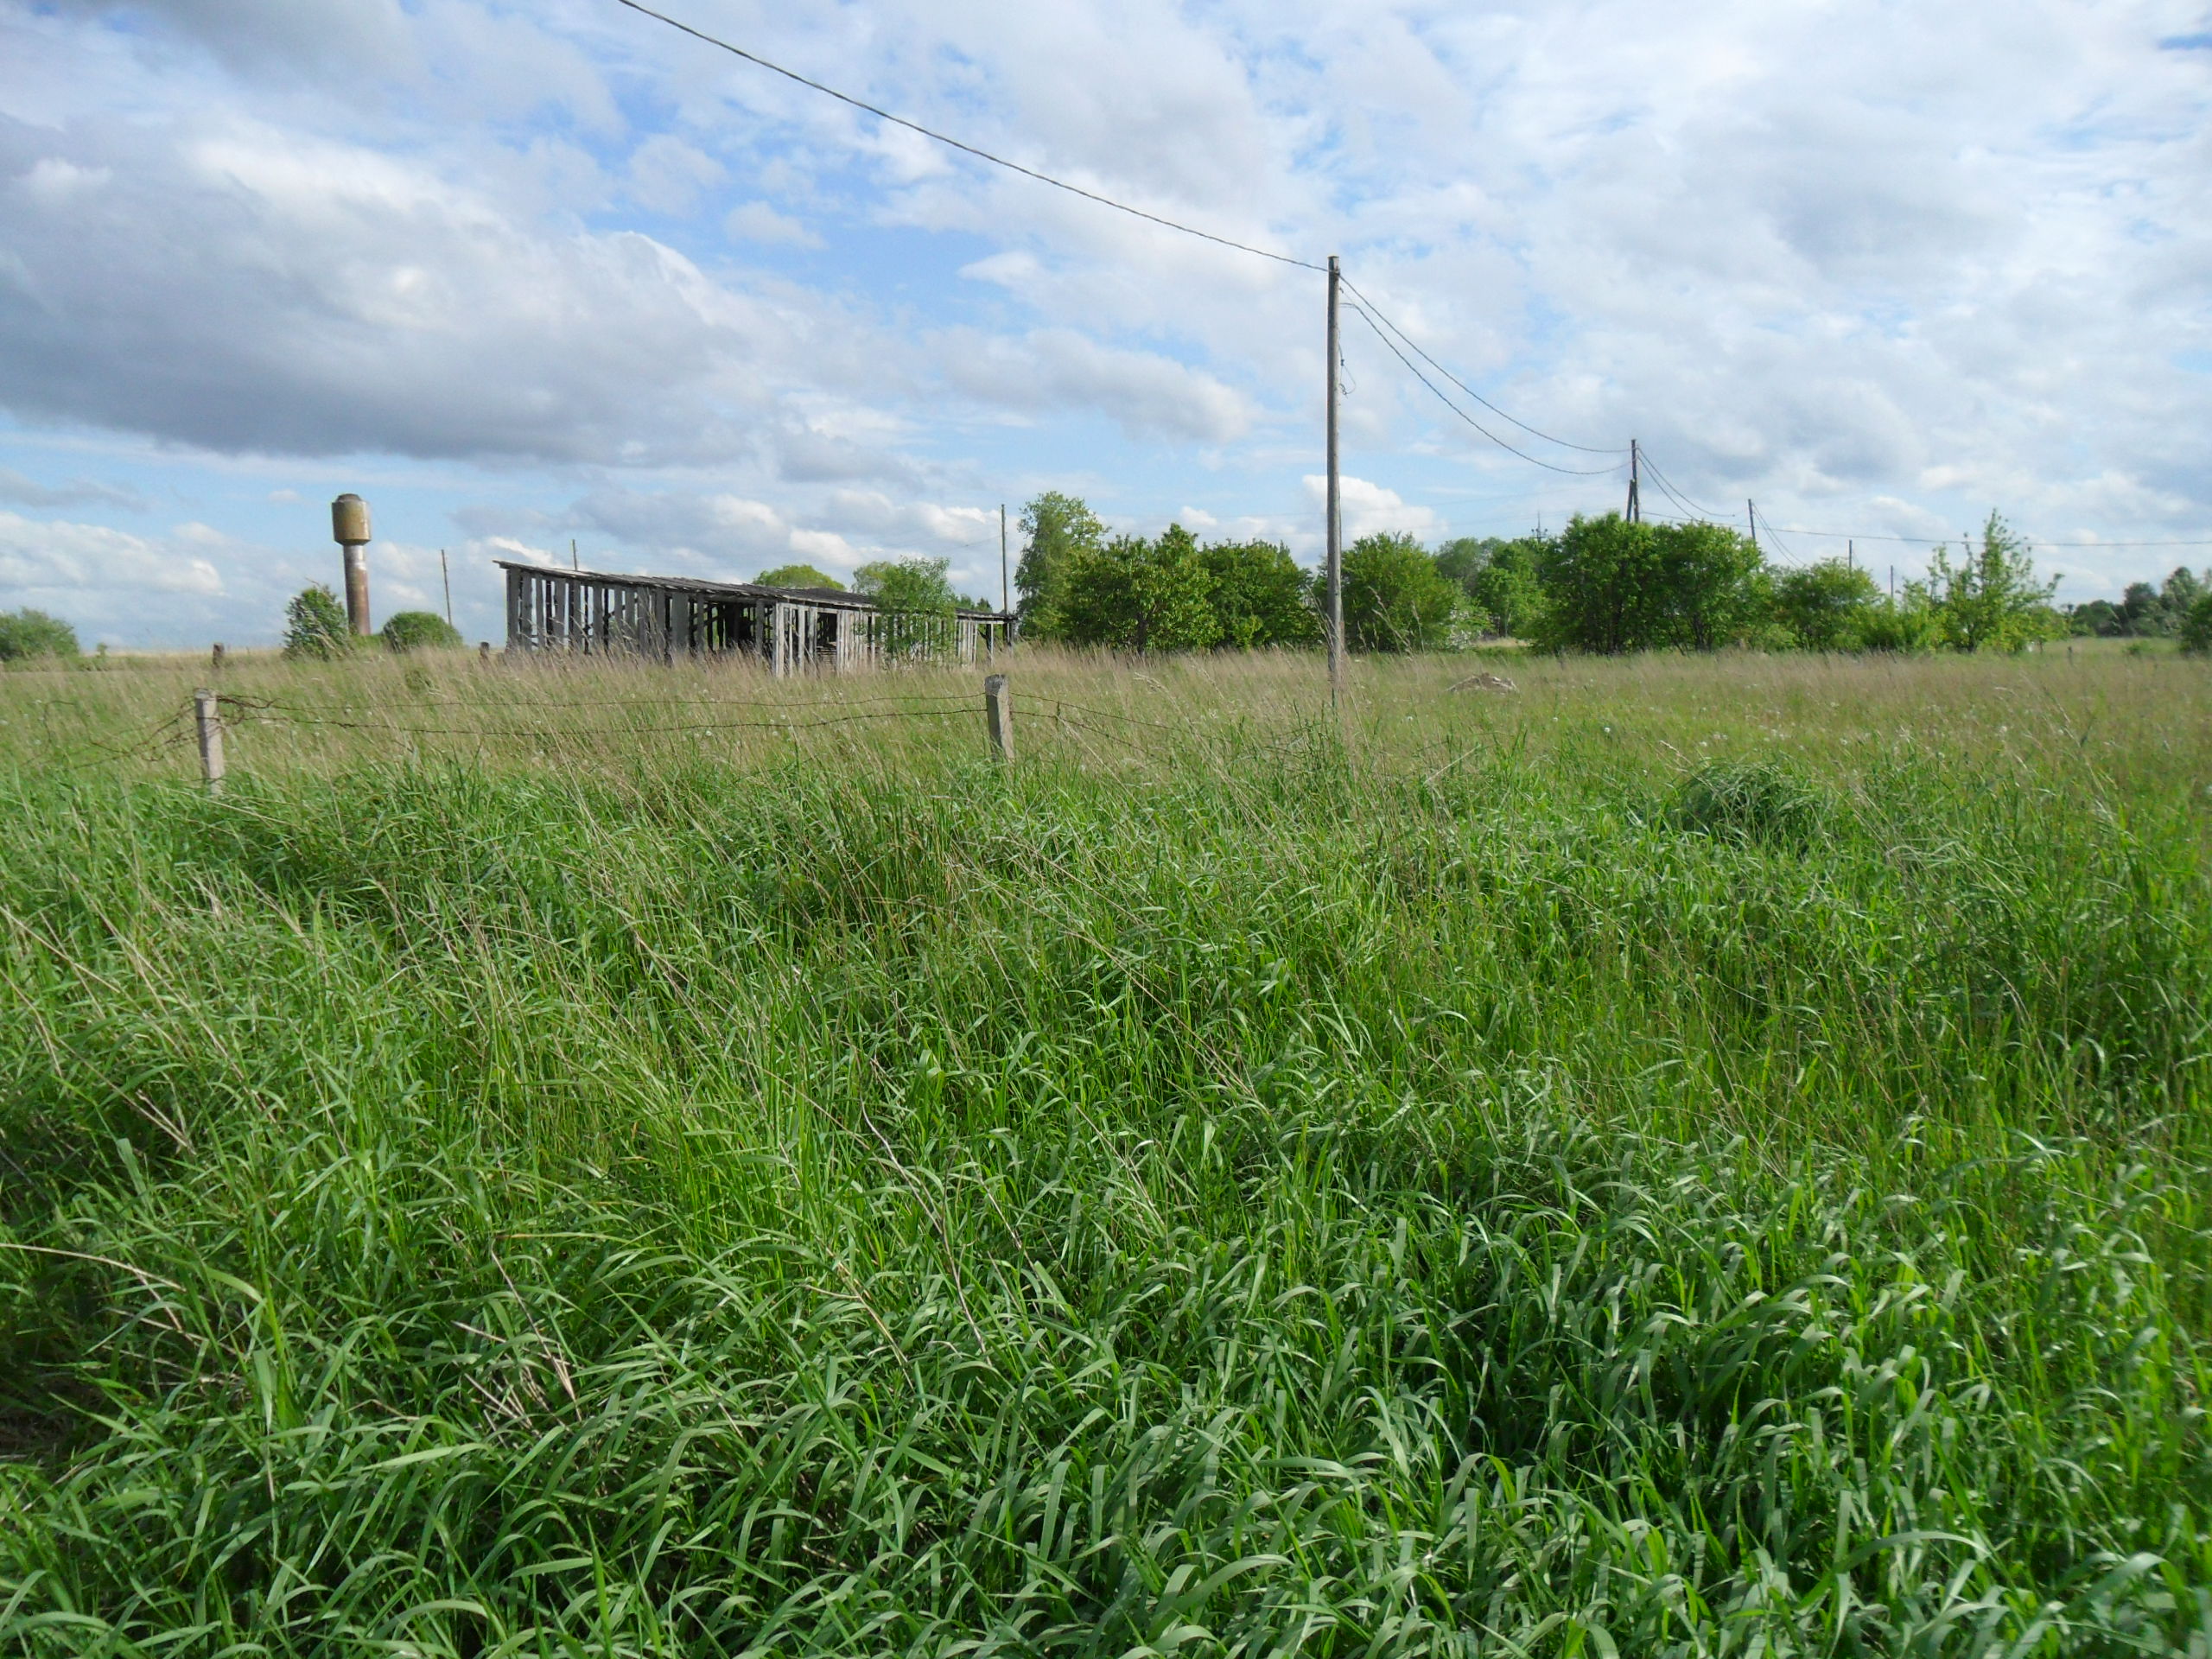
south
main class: Grassland
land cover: Grassland without tree/shrub cover
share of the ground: > 75 %
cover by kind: herbaceous plants 75 %
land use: Abandoned areas
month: June
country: LV
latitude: 57.3799
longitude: 22.4775
